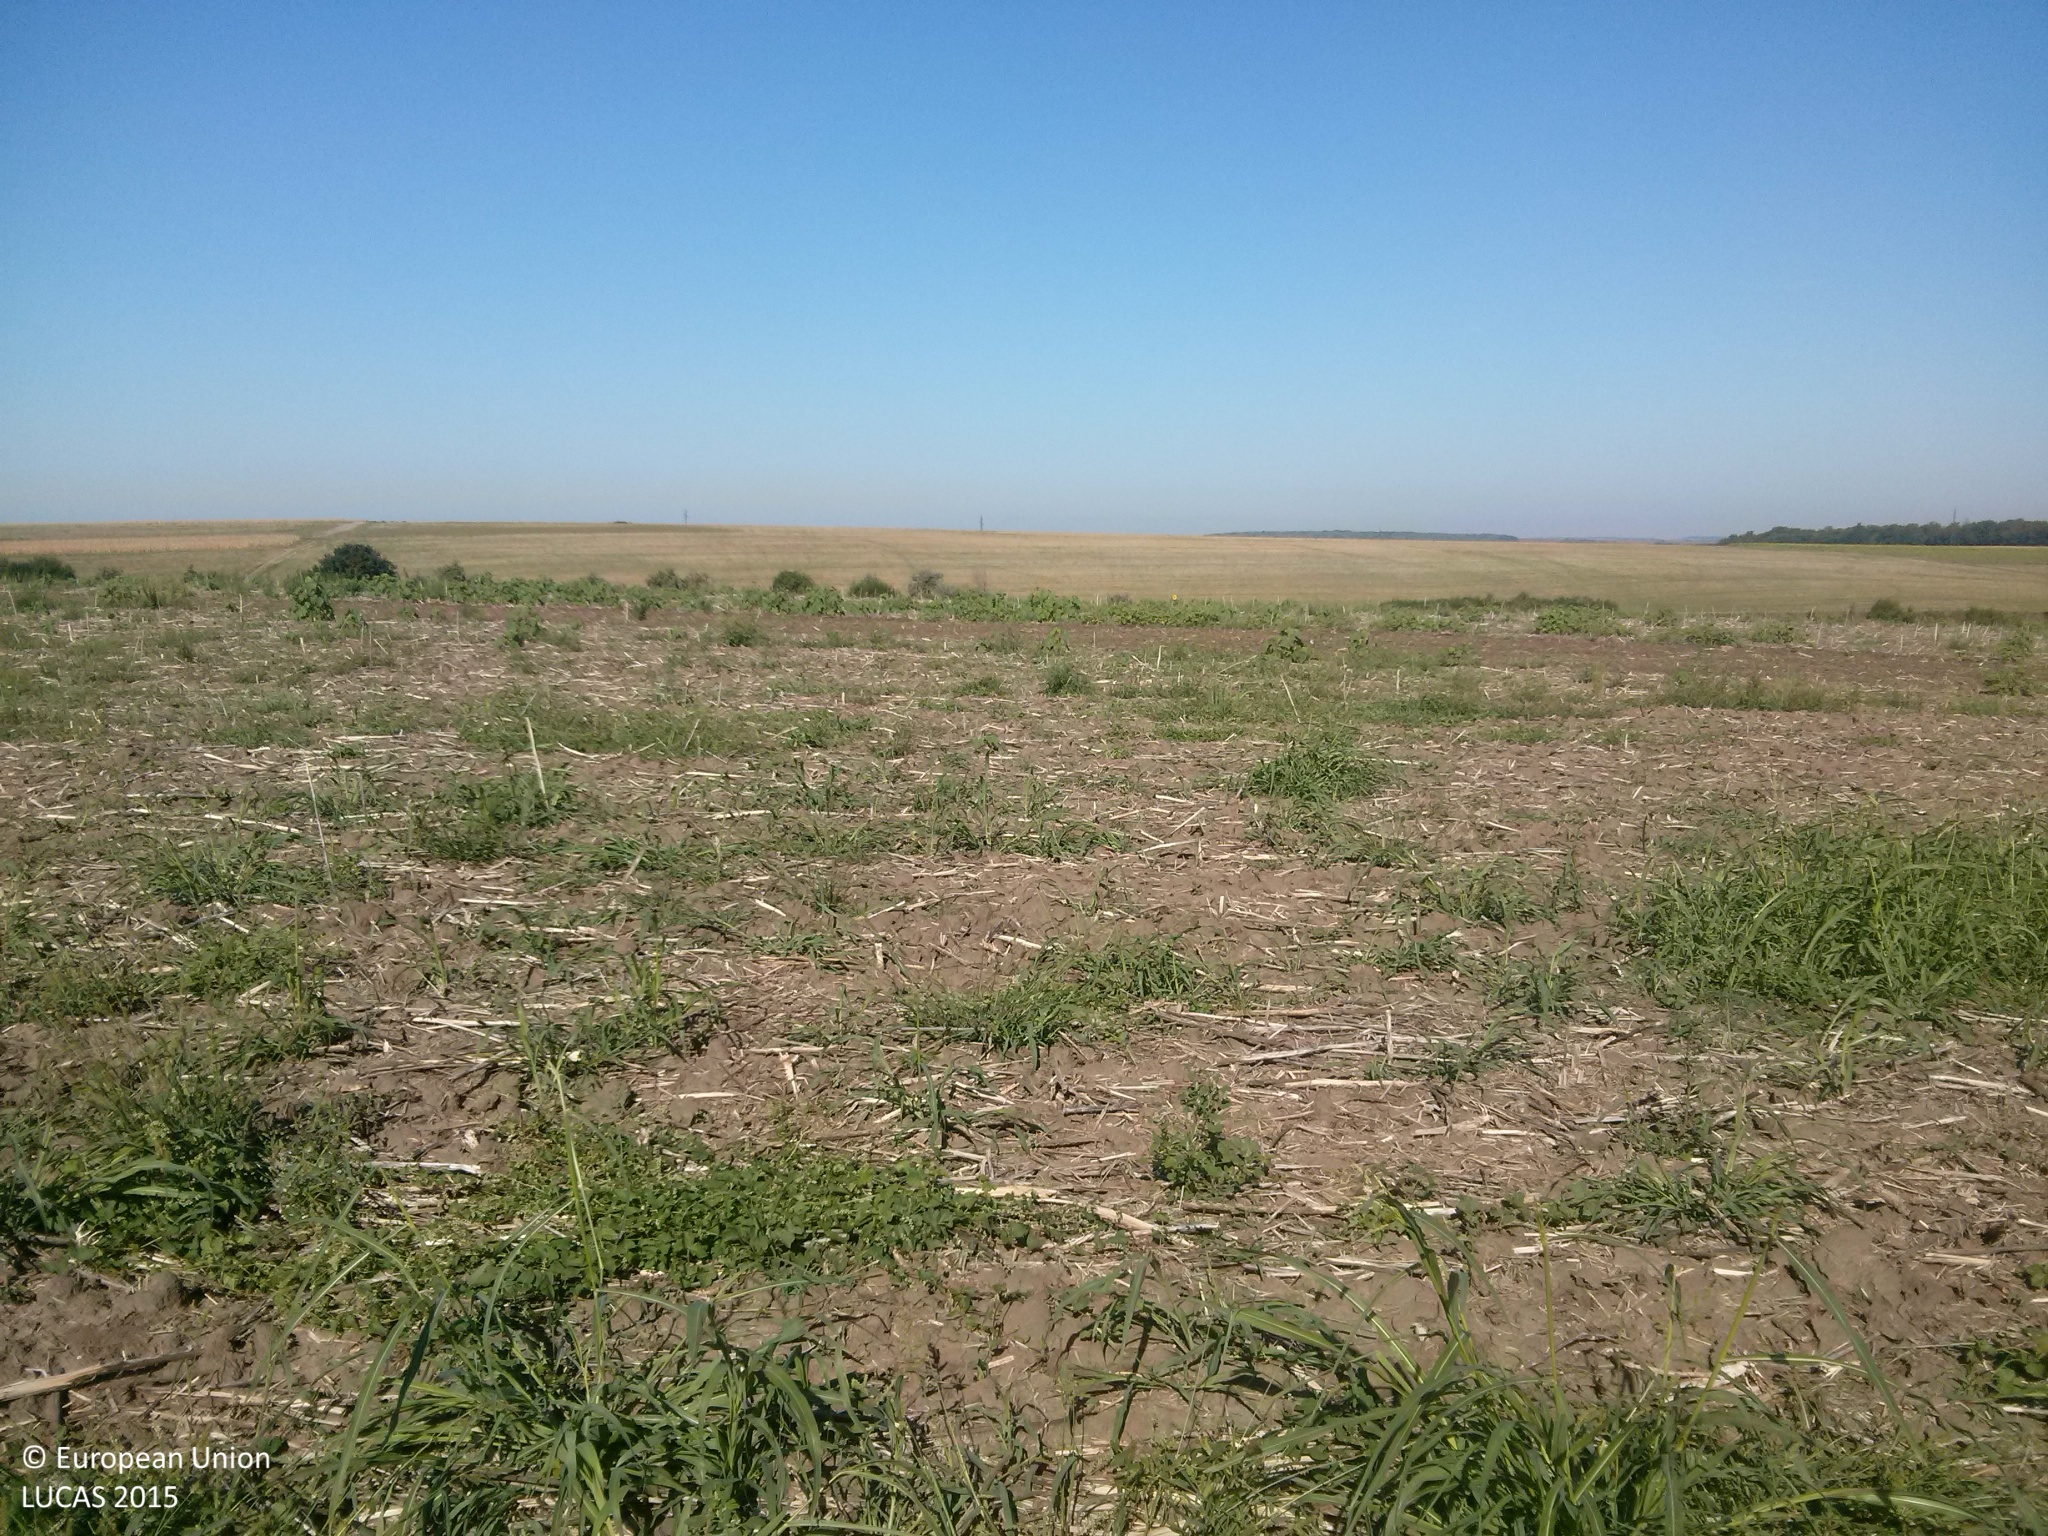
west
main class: Cropland
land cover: Rape and turnip rape
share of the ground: < 10 %
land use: Agriculture (excluding fallow land and kitchen gardens)
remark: Harvested field
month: September
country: BG
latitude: 43.7538
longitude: 26.3869
